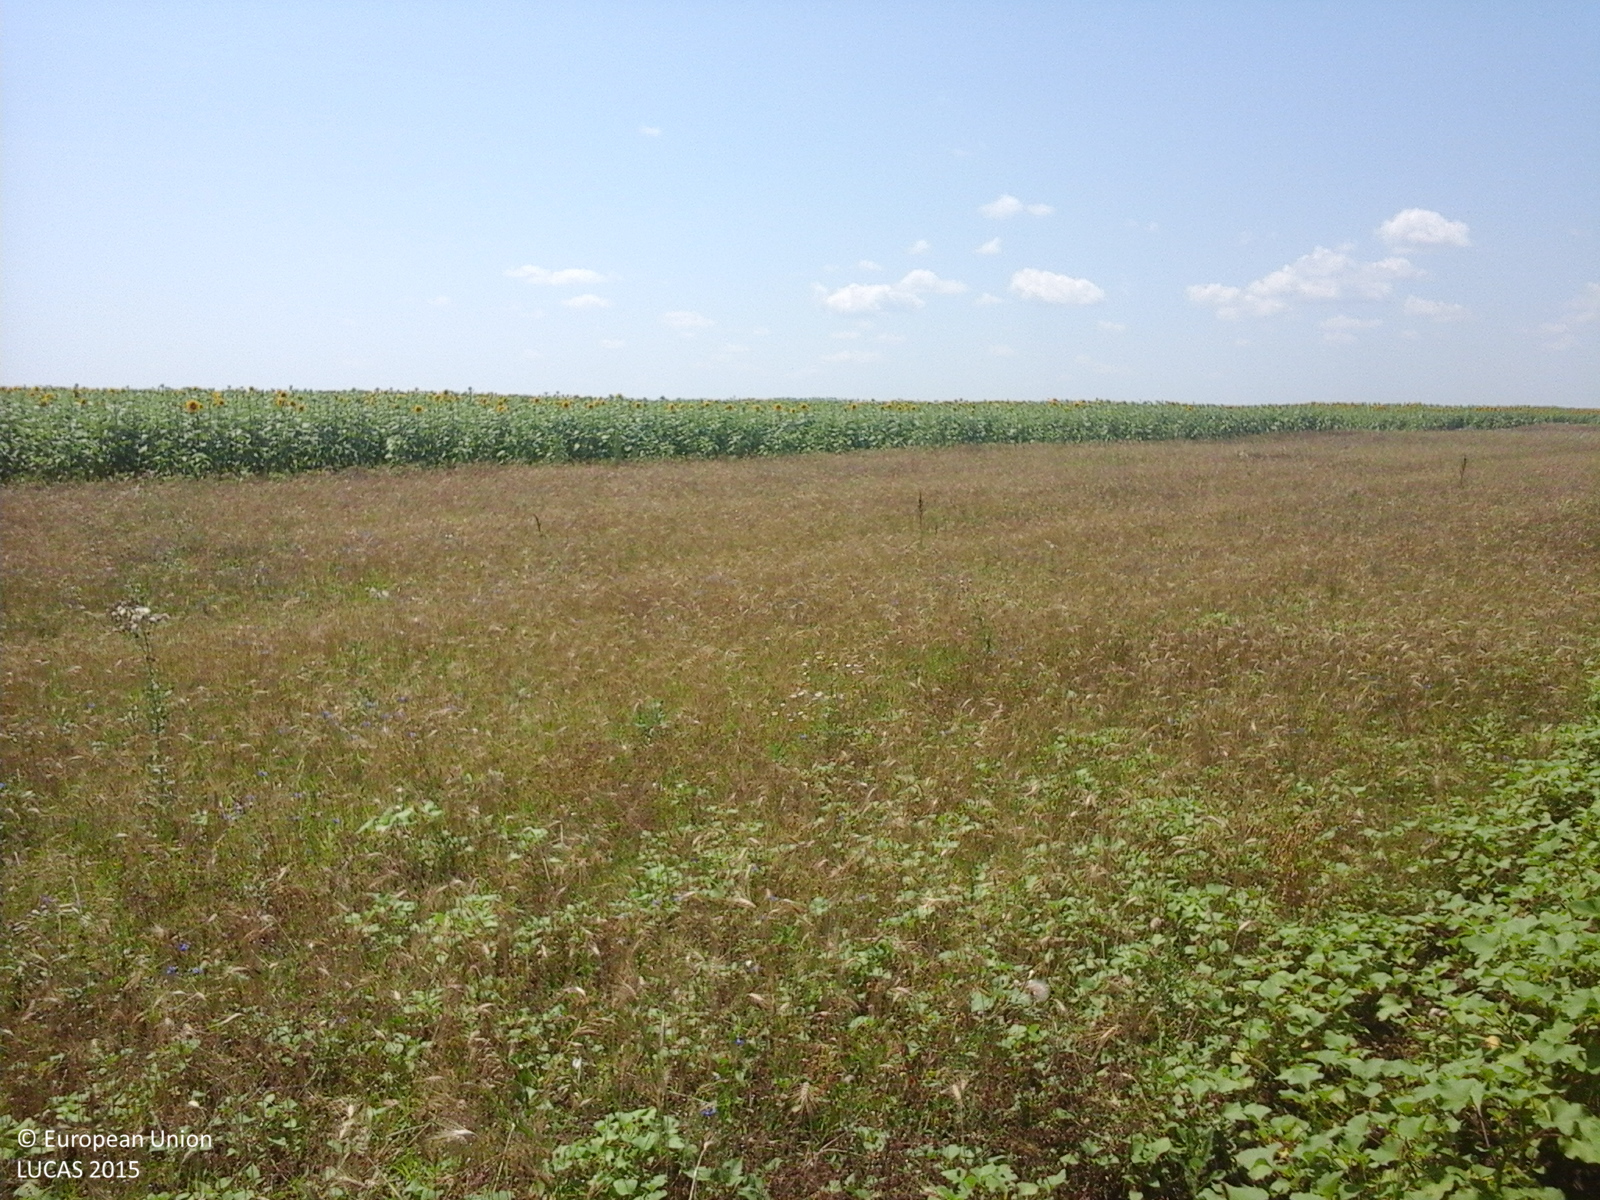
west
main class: Cropland
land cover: Sunflower
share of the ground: 25 - 50 %
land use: Agriculture (excluding fallow land and kitchen gardens)
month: July
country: RO
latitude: 44.1970
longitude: 24.2909
